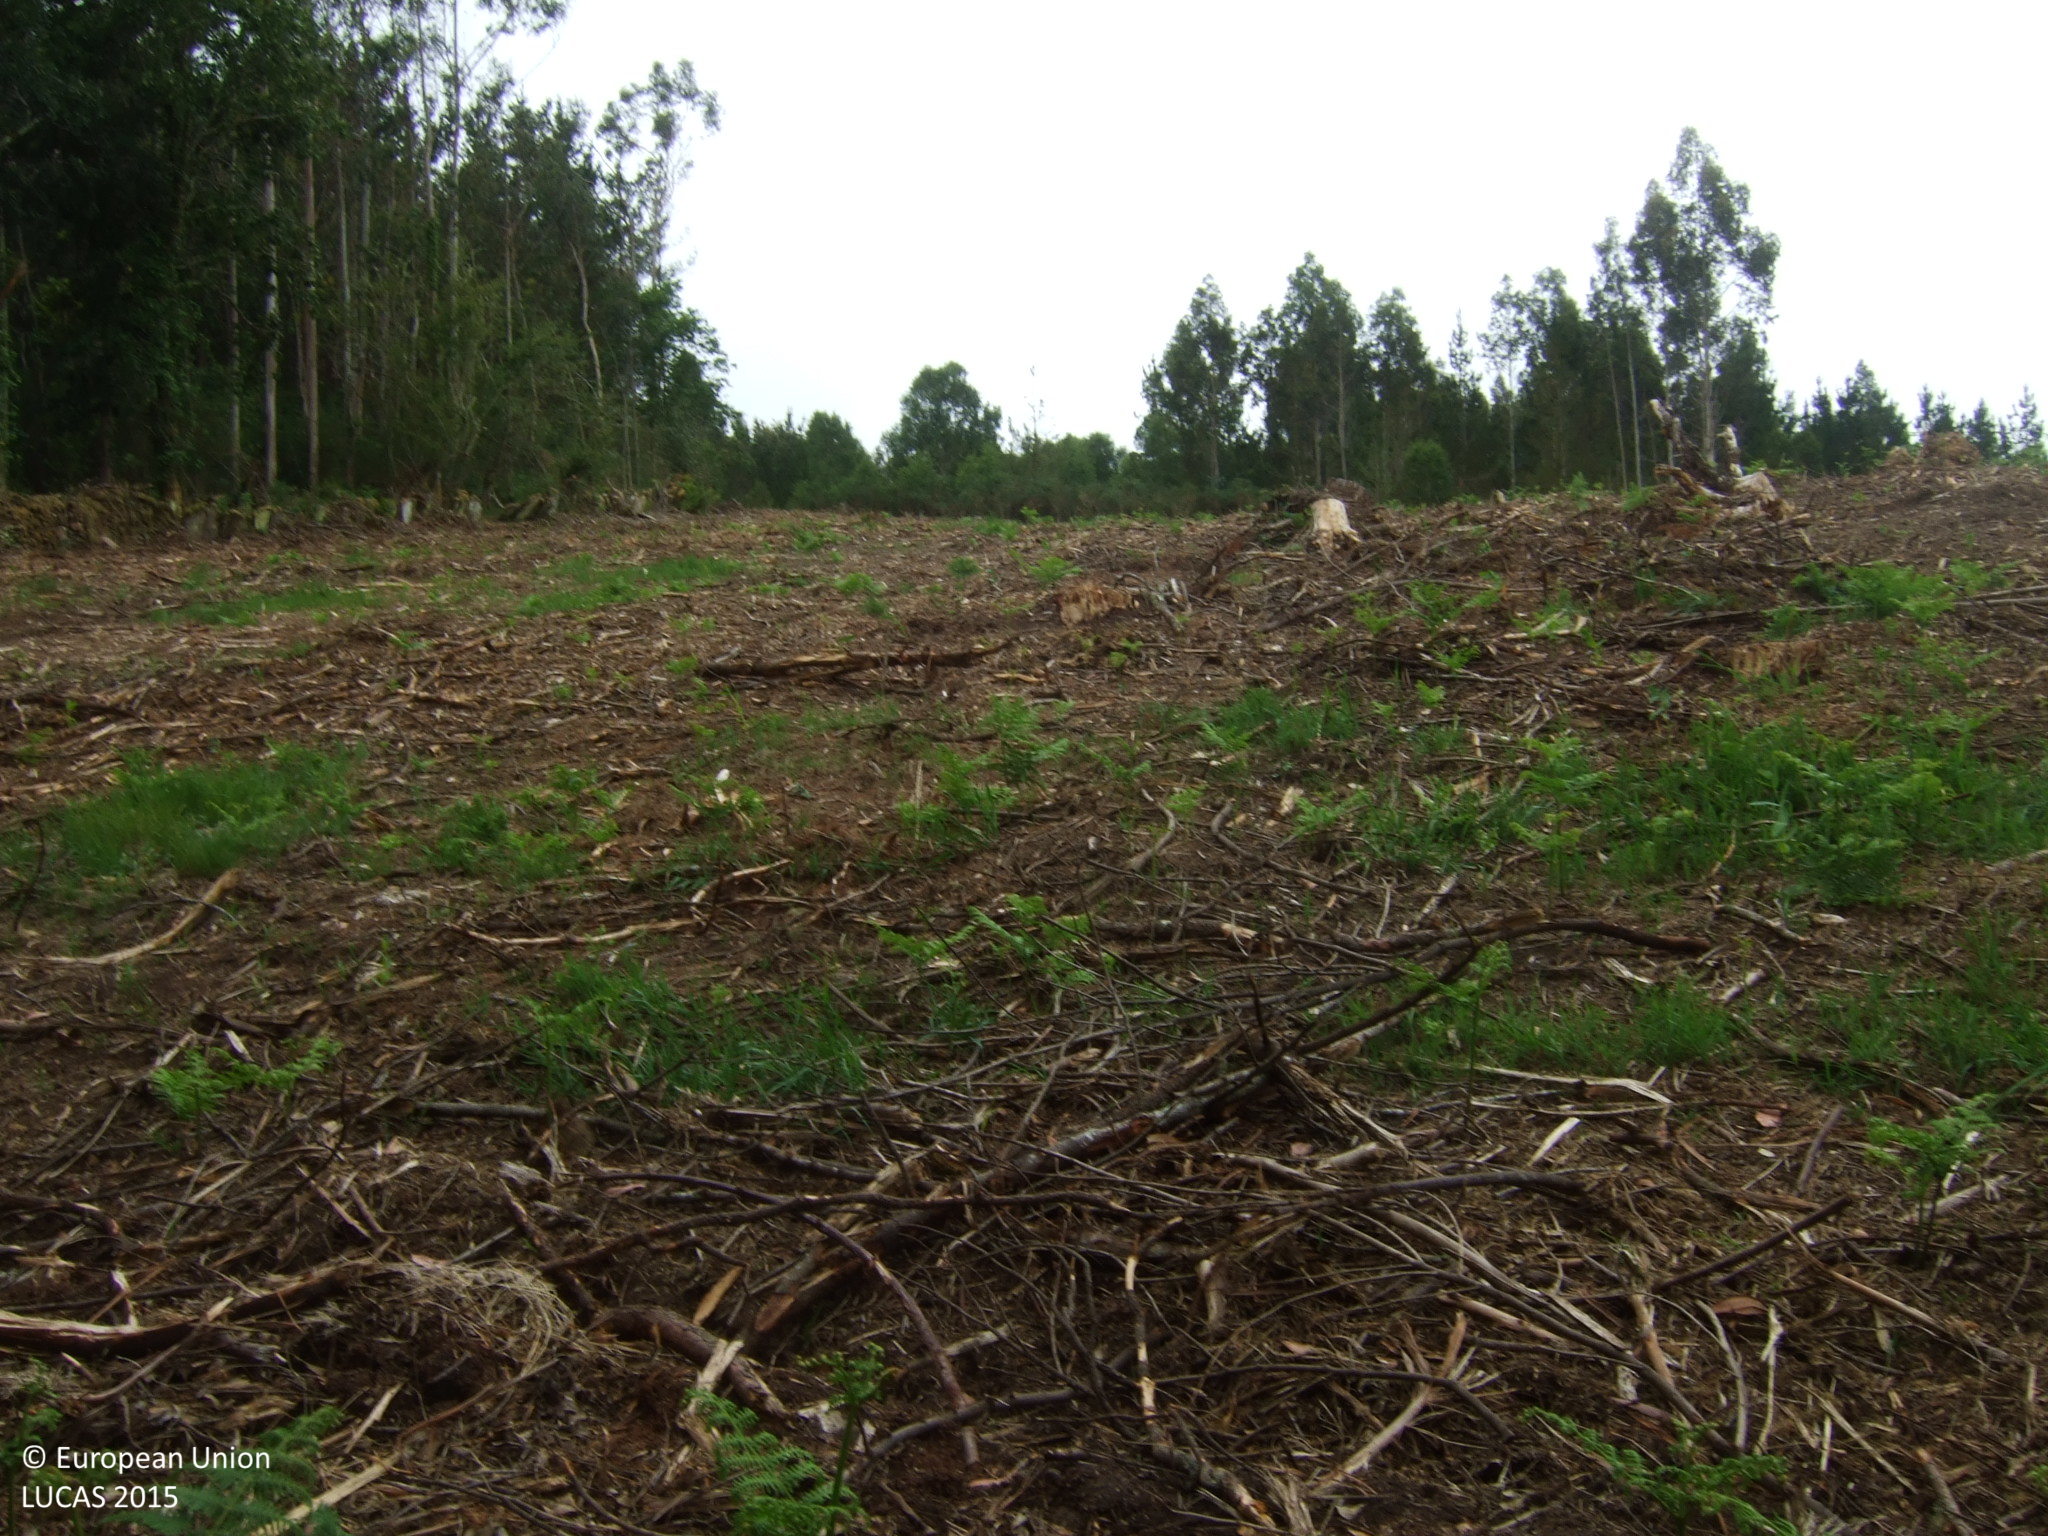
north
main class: Woodland
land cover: Broadleaved woodland
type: exotic forest
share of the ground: 25 - 50 %
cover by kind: shrubs 60 %, broadleaved forest trees 40 %
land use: Forestry
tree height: > 5 m
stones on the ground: < 10 %
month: June
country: ES
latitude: 43.5775
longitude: -7.7610
